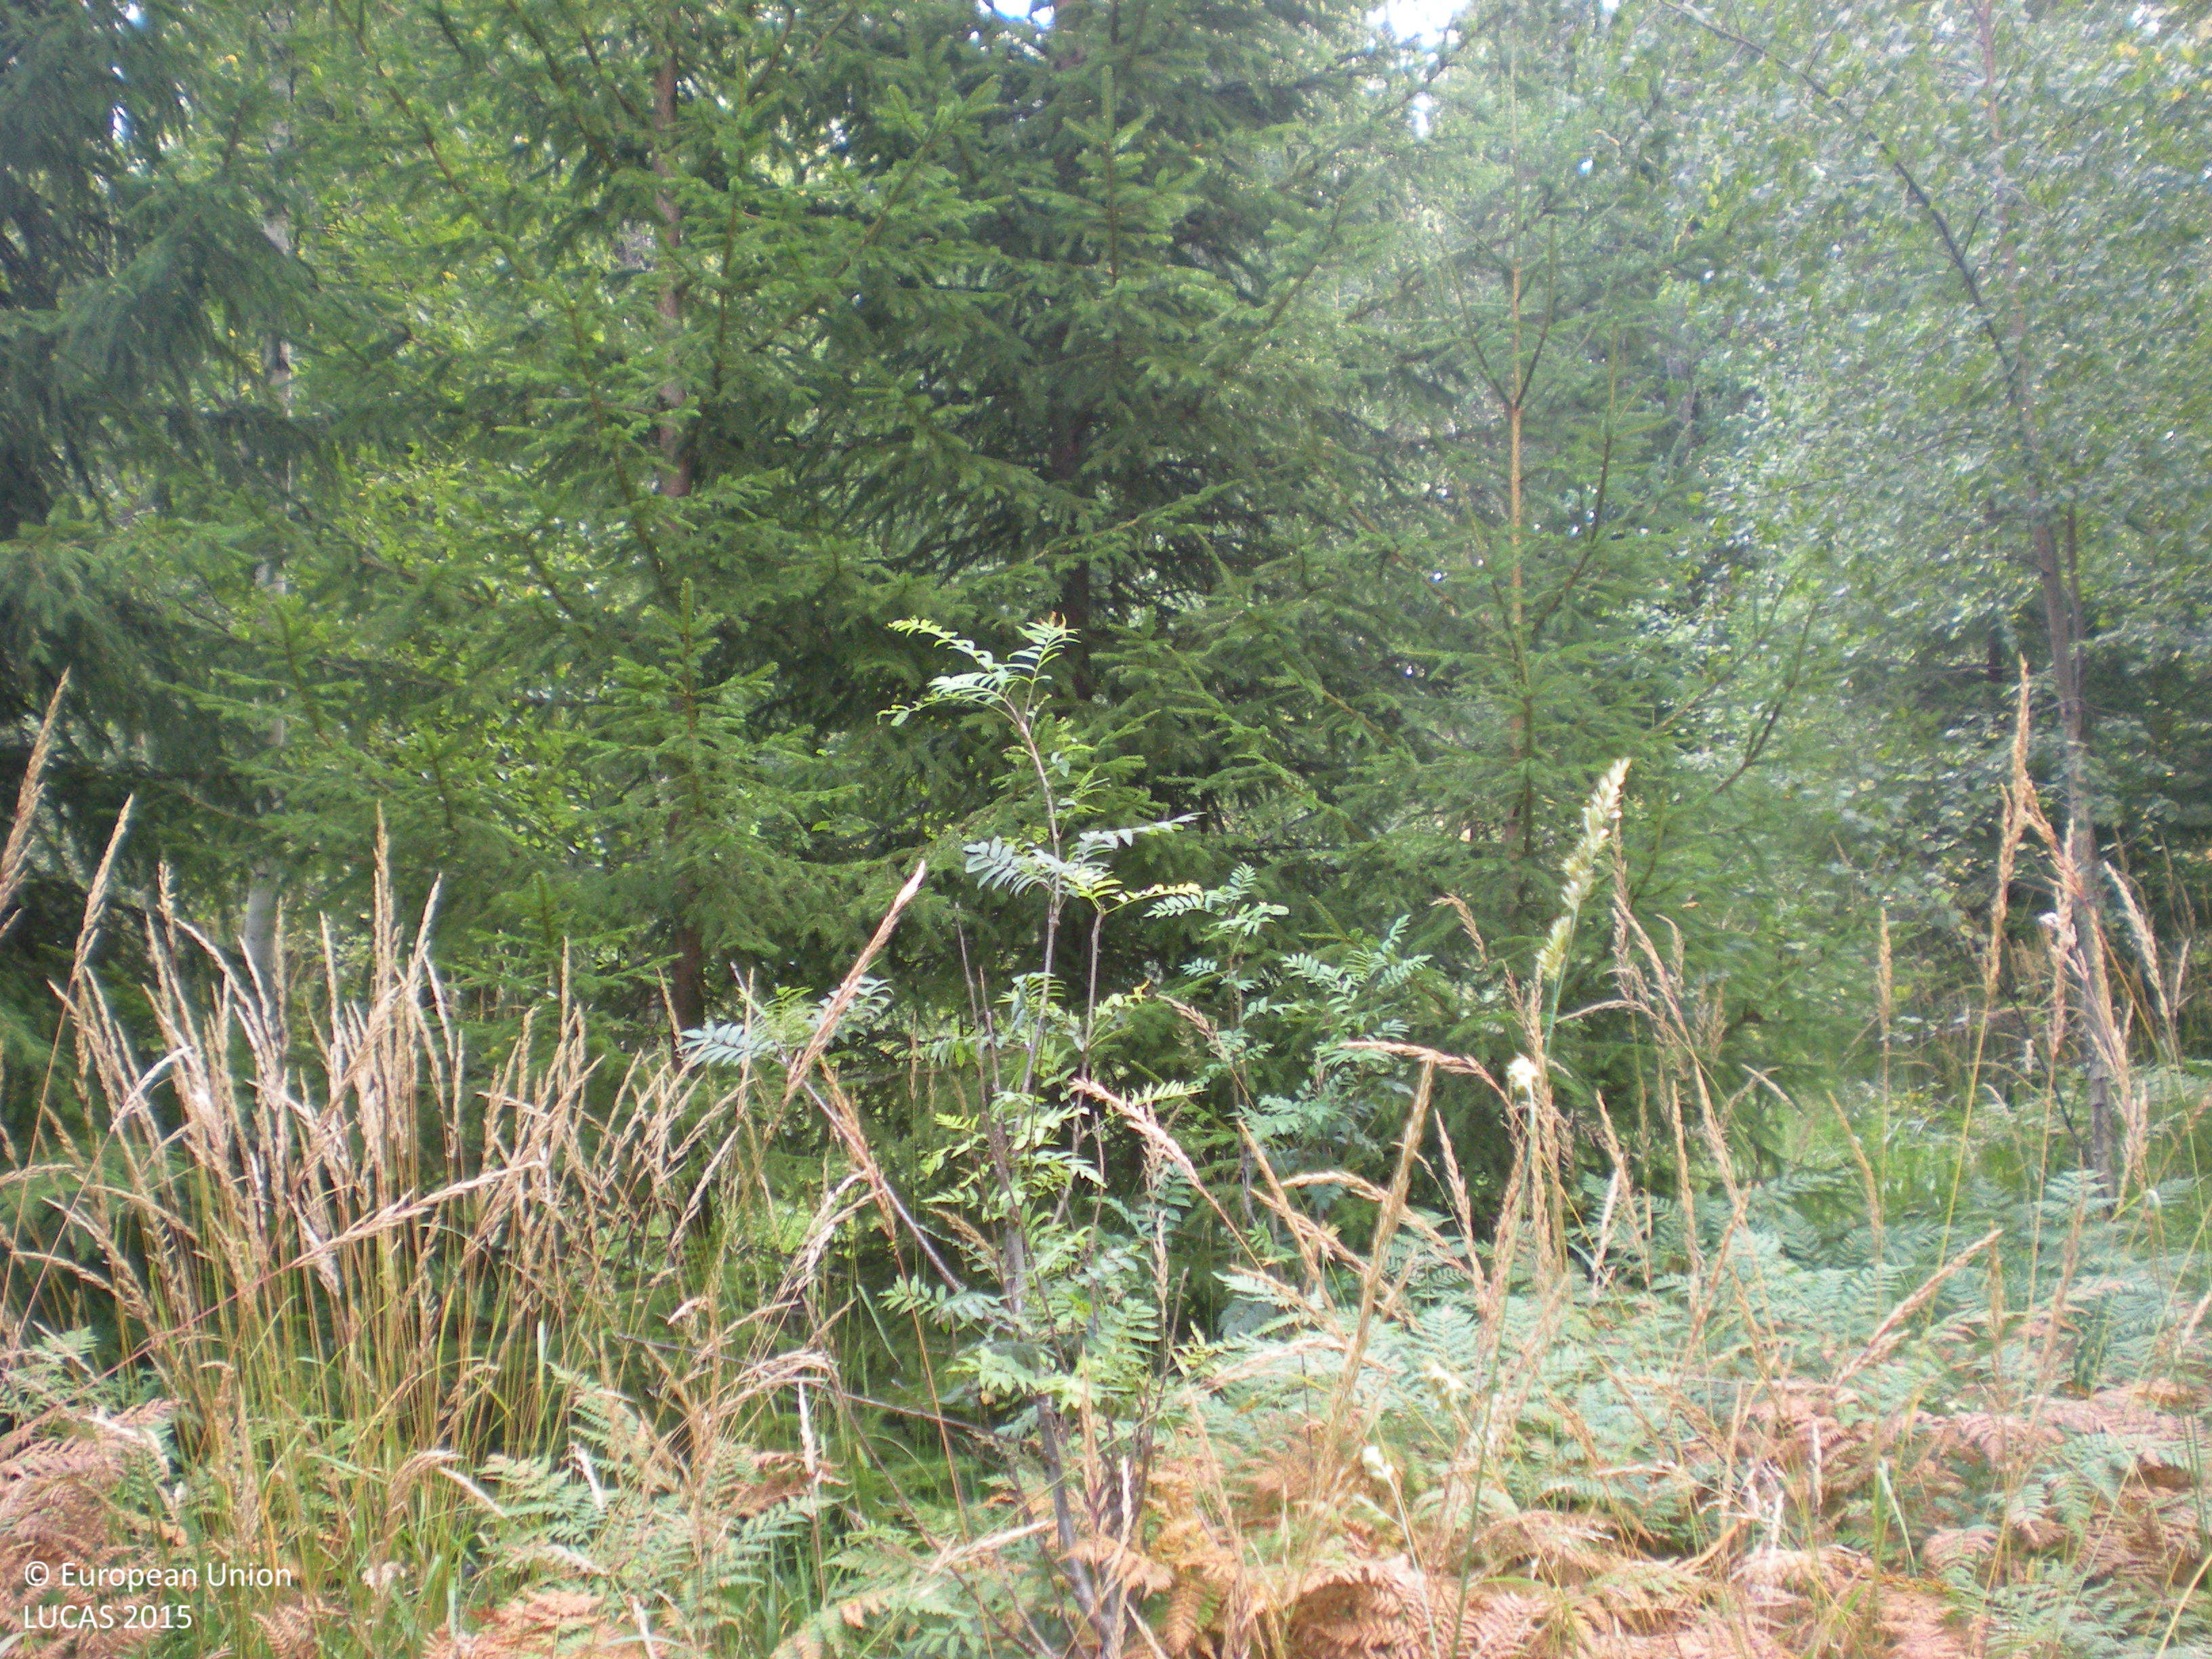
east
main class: Woodland
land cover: Spruce dominated mixed woodland
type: boreal forest
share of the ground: 50 - 75 %
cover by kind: herbaceous plants 35 %, coniferous forest trees 30 %, broadleaved forest trees 25 %, shrubs 5 %, lichens and mosses 5 %
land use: Forestry
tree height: > 5 m
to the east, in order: Spruce dominated mixed woodland; Ditches and canals; Spruce dominated coniferous woodland; Pine dominated coniferous woodland; Spruce dominated coniferous woodland; Spruce dominated mixed woodland
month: August
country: SE
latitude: 60.4522
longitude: 17.1343
